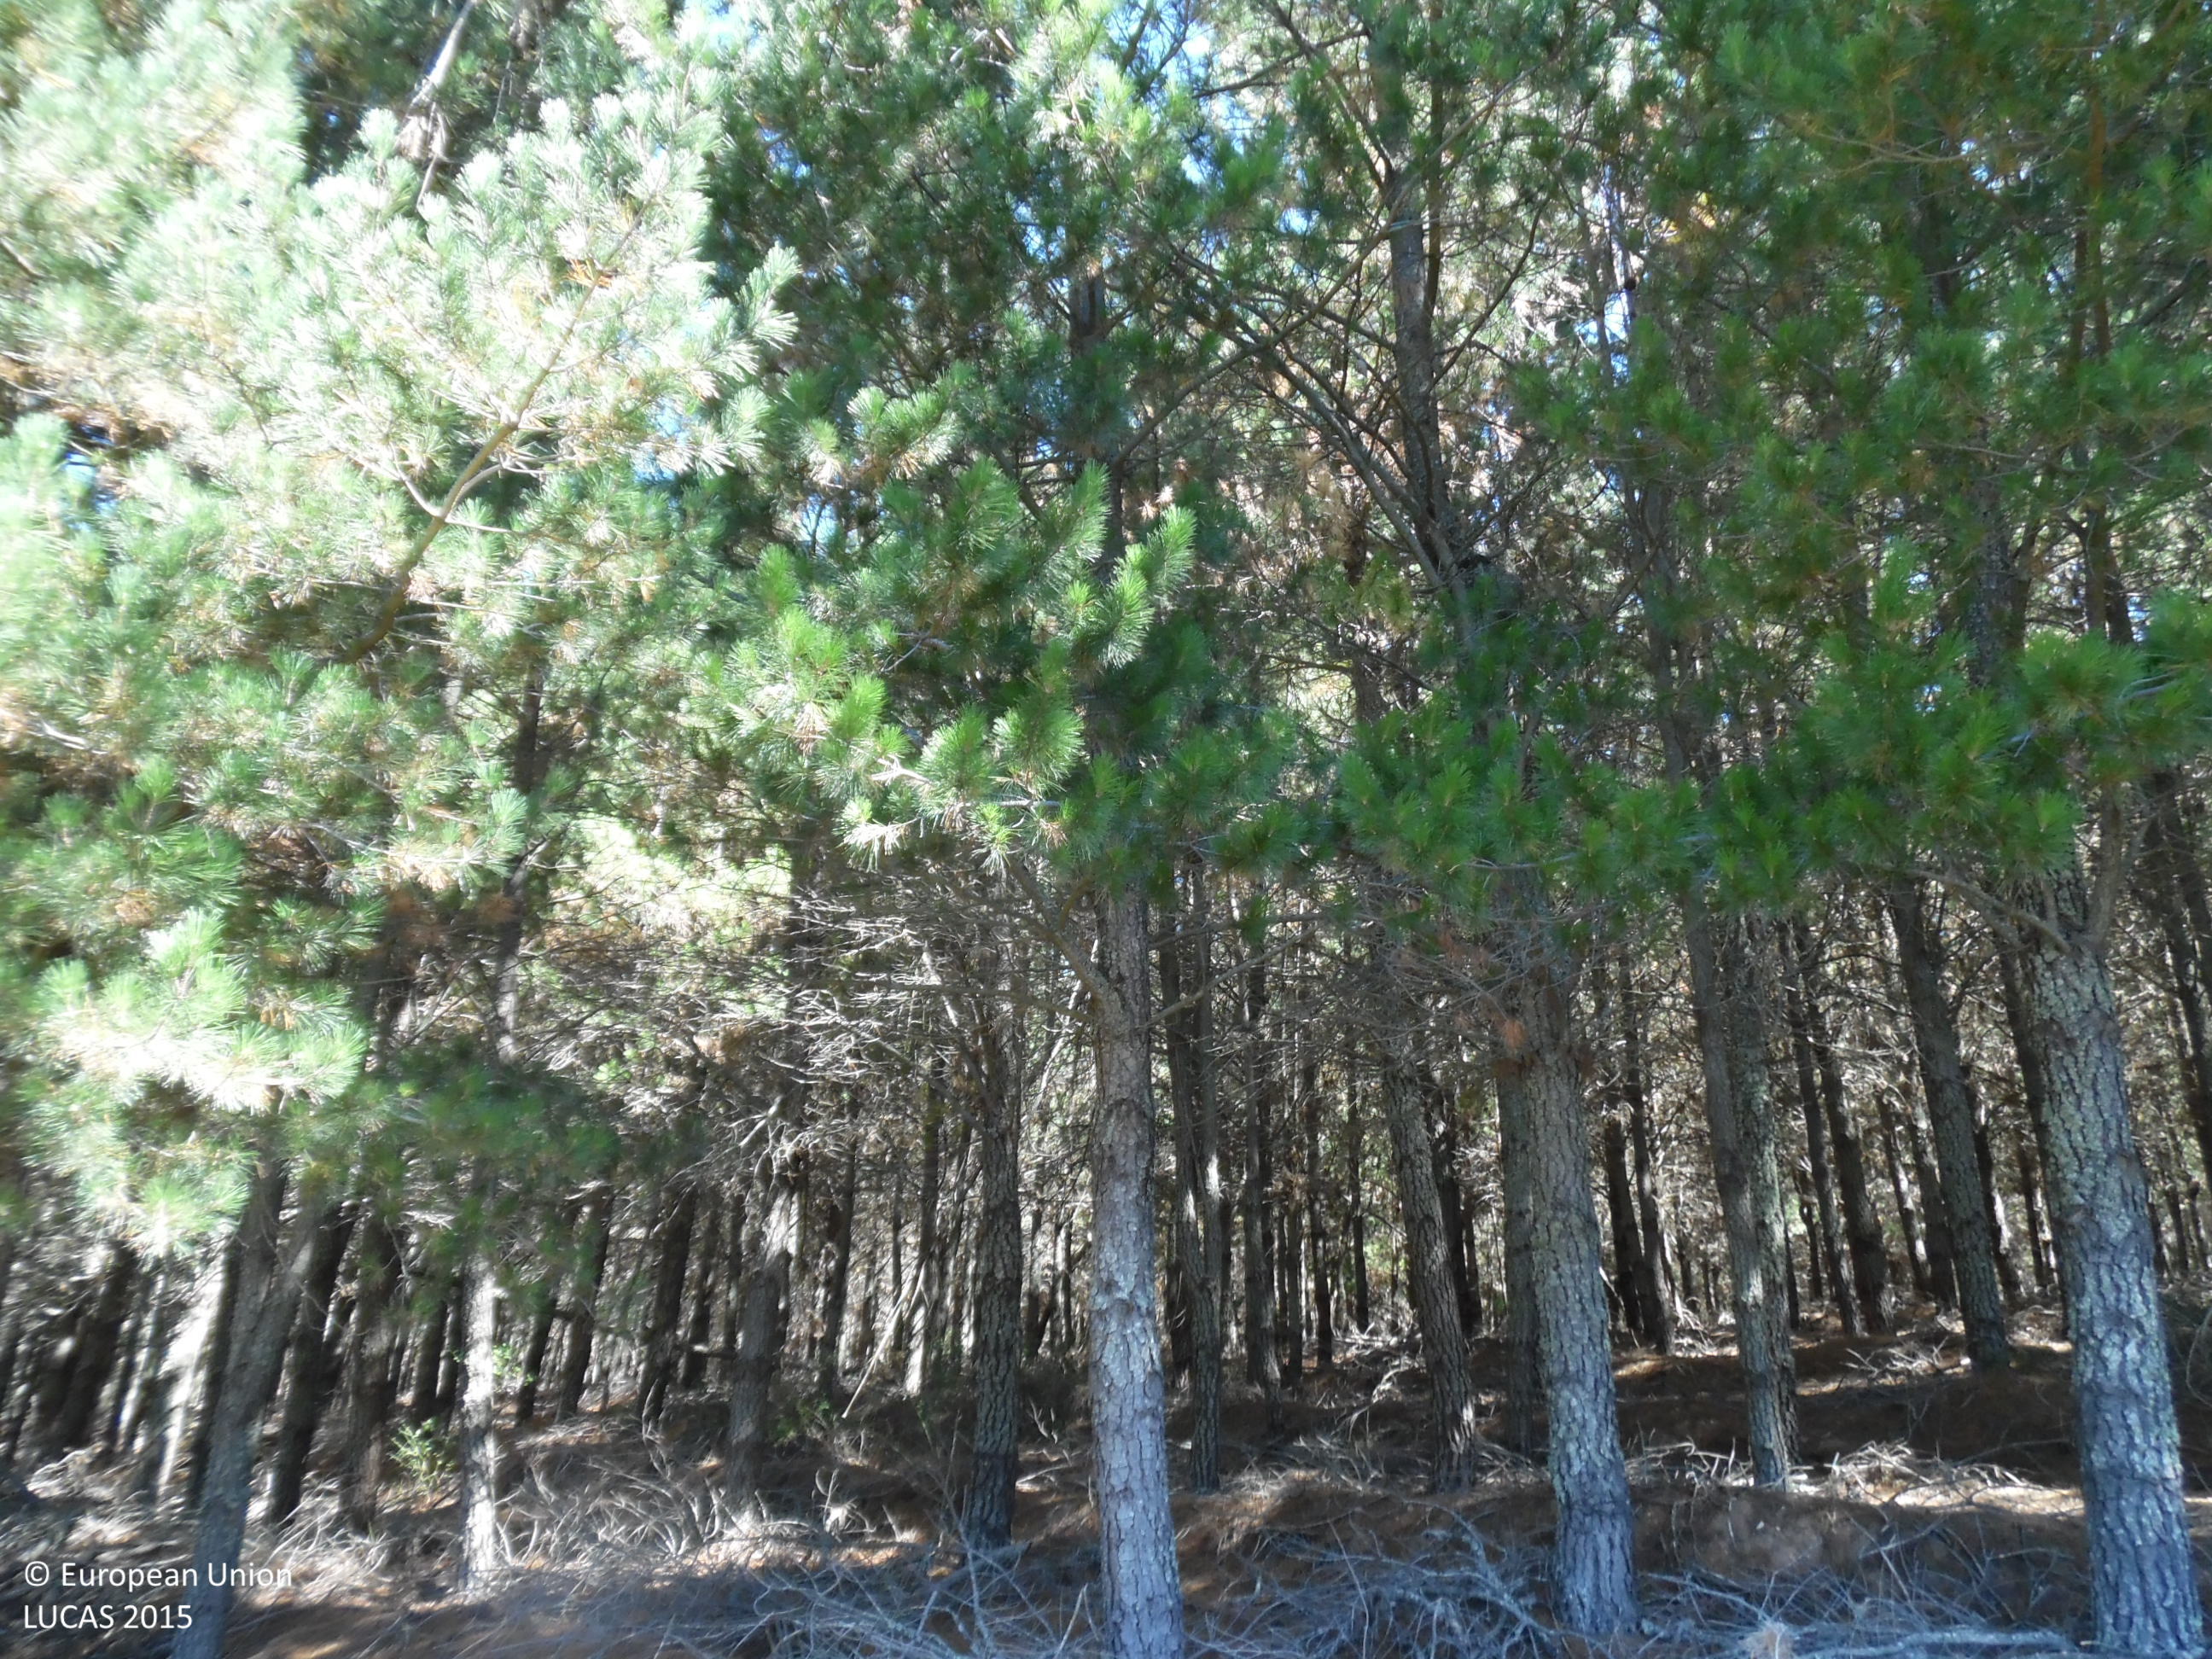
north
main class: Shrubland
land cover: Shrubland with sparse tree cover
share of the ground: > 75 %
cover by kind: shrubs 95 %, coniferous forest trees 5 %
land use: Abandoned areas
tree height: < 5 m
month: August
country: ES
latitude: 42.6802
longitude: -6.4337
